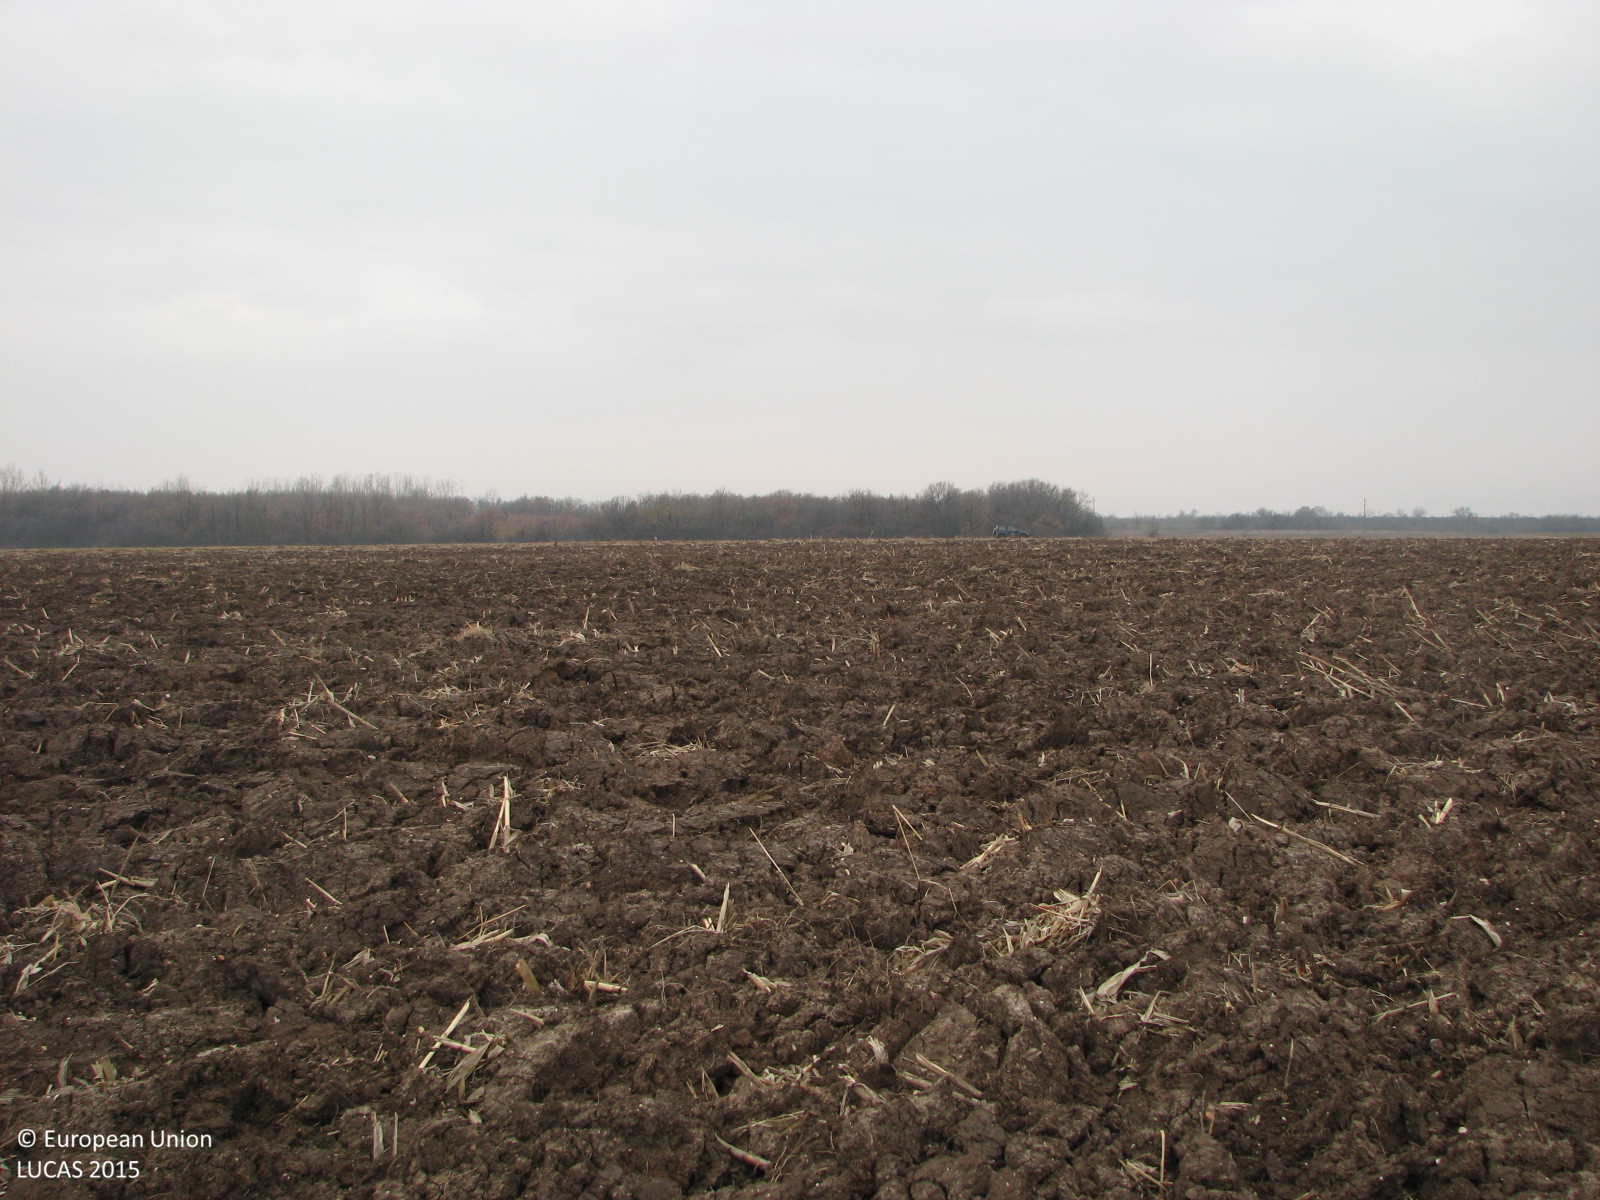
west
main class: Cropland
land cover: Maize
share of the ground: < 10 %
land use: Agriculture (excluding fallow land and kitchen gardens)
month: December
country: BG
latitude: 42.3932
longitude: 24.9885
